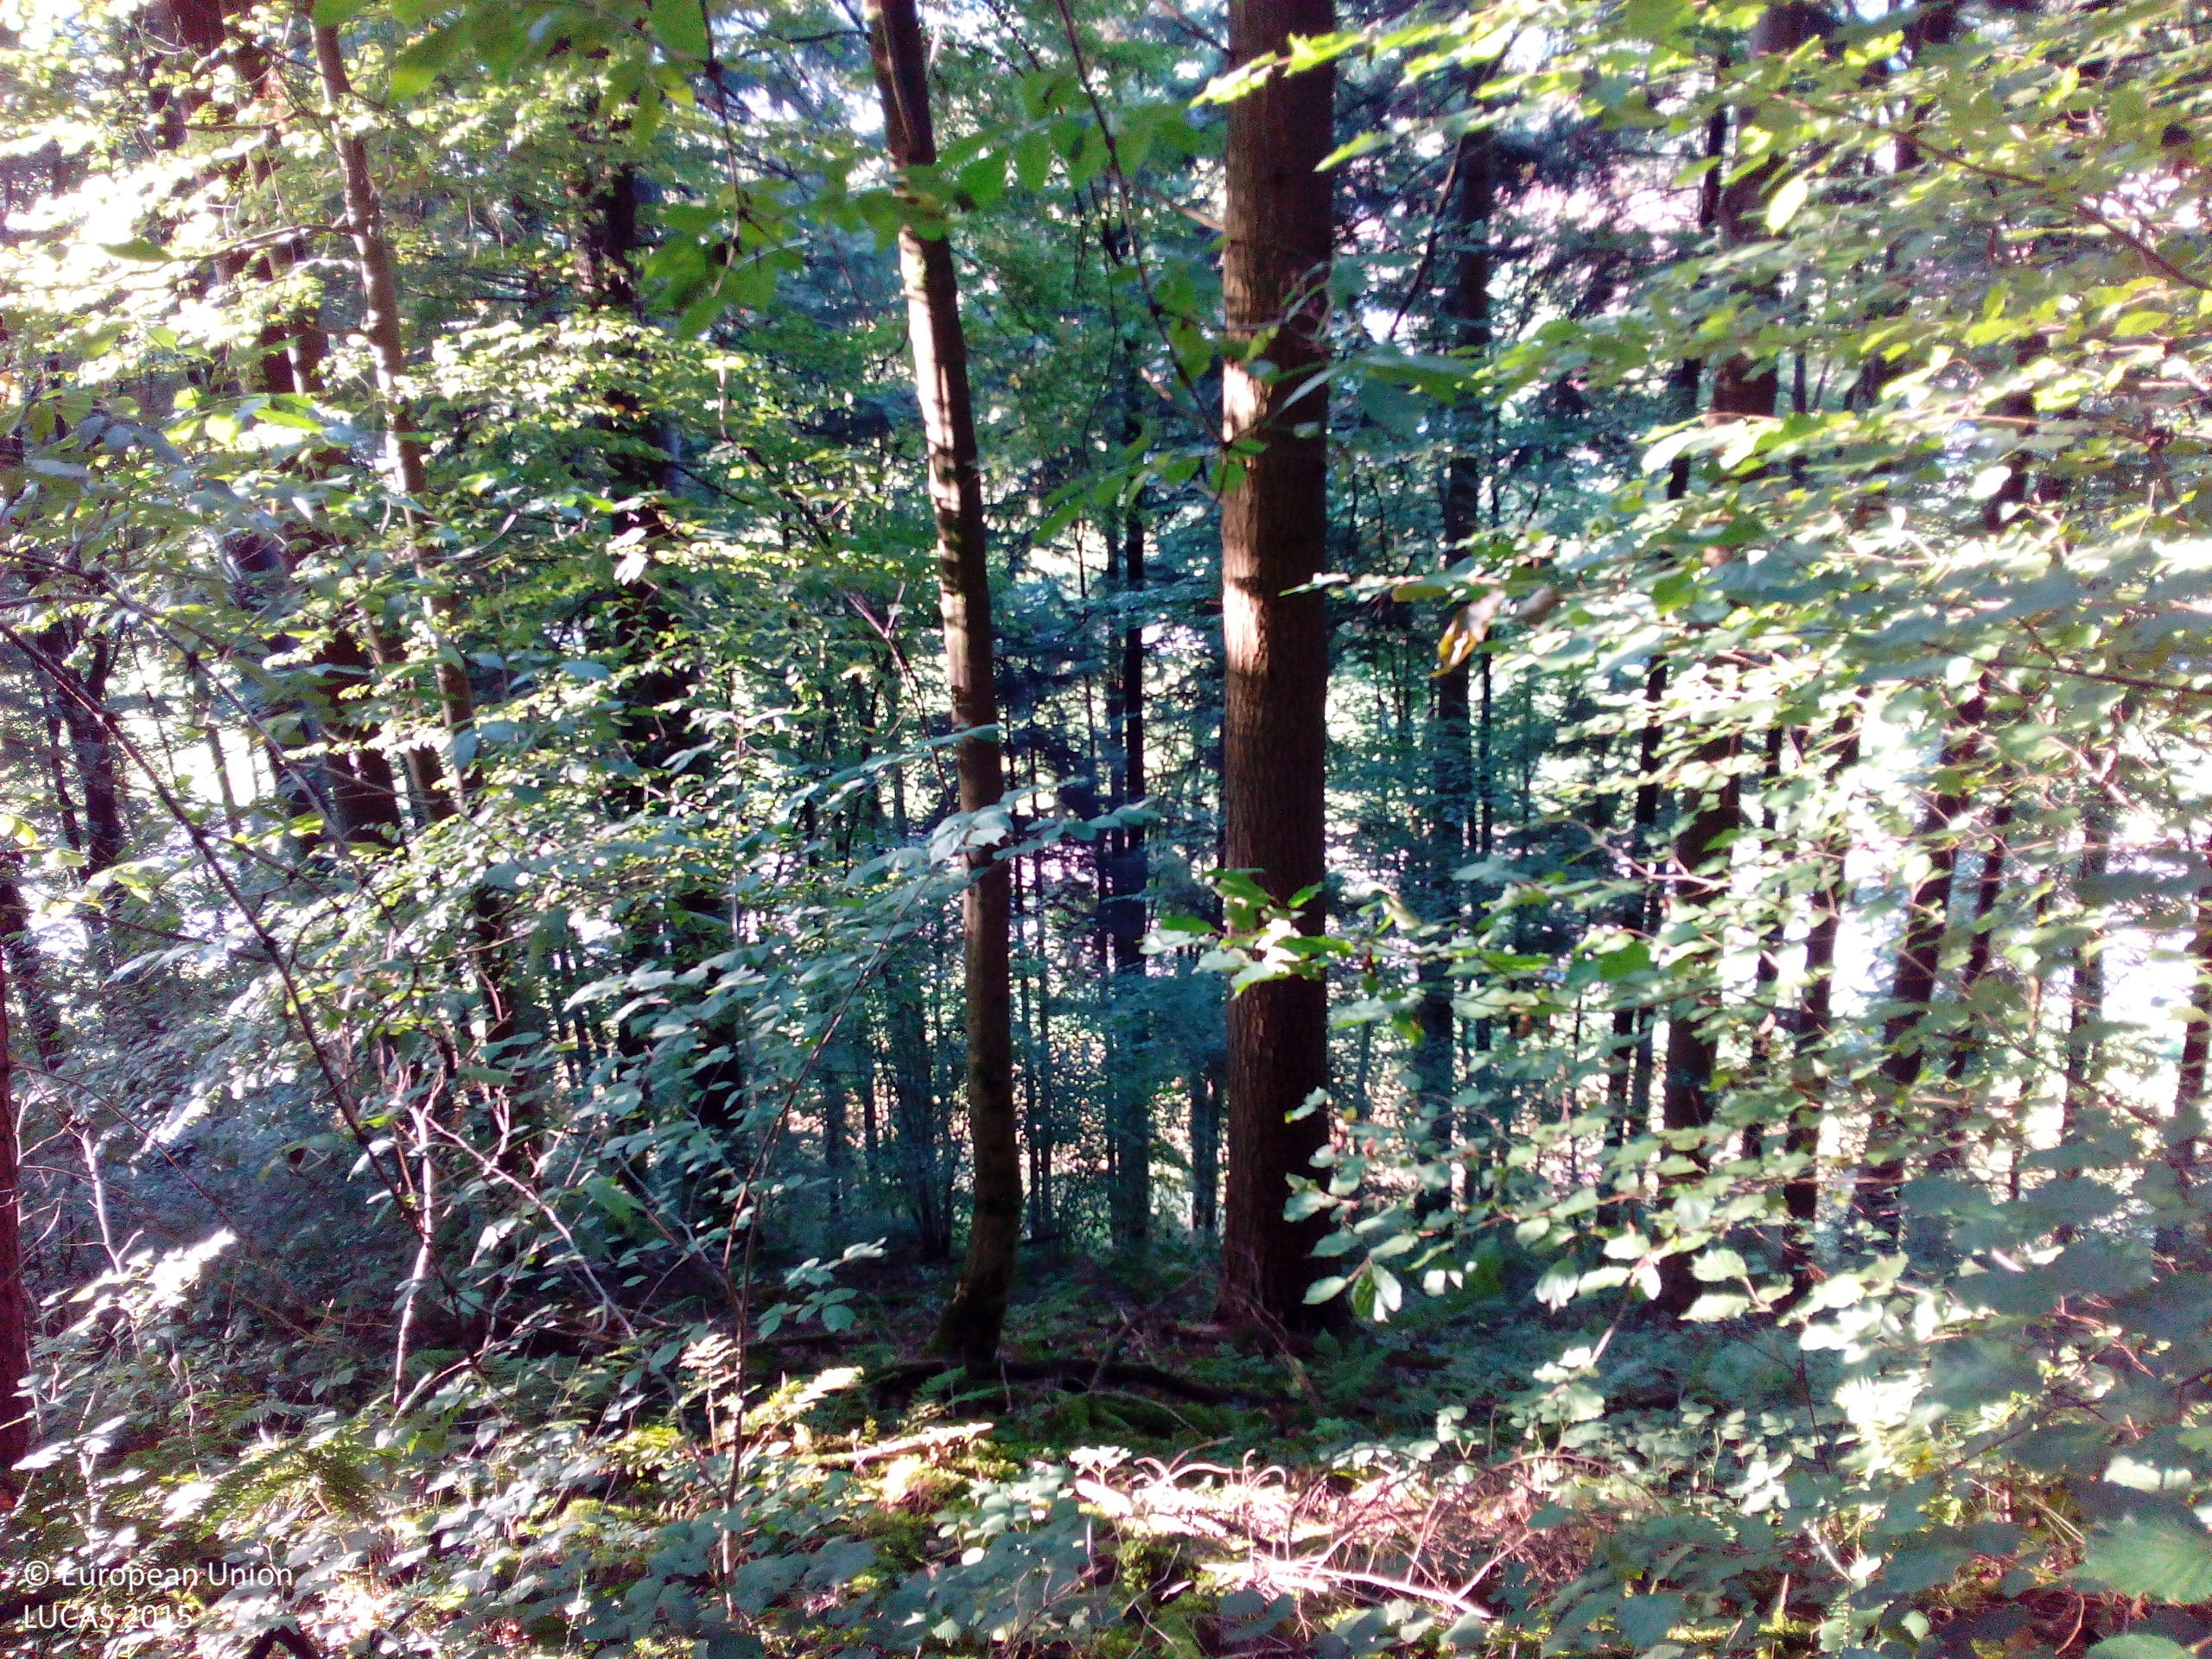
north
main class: Woodland
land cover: Spruce dominated mixed woodland
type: hemiboreal forest and nemoral coniferous forest and mixed broadleaved-coniferous forest
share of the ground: 50 - 75 %
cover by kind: coniferous forest trees 50 %, broadleaved forest trees 20 %, shrubs 10 %, herbaceous plants 10 %, lichens and mosses 10 %
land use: Forestry
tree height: > 5 m
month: September
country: DE
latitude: 48.2796
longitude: 8.1278
